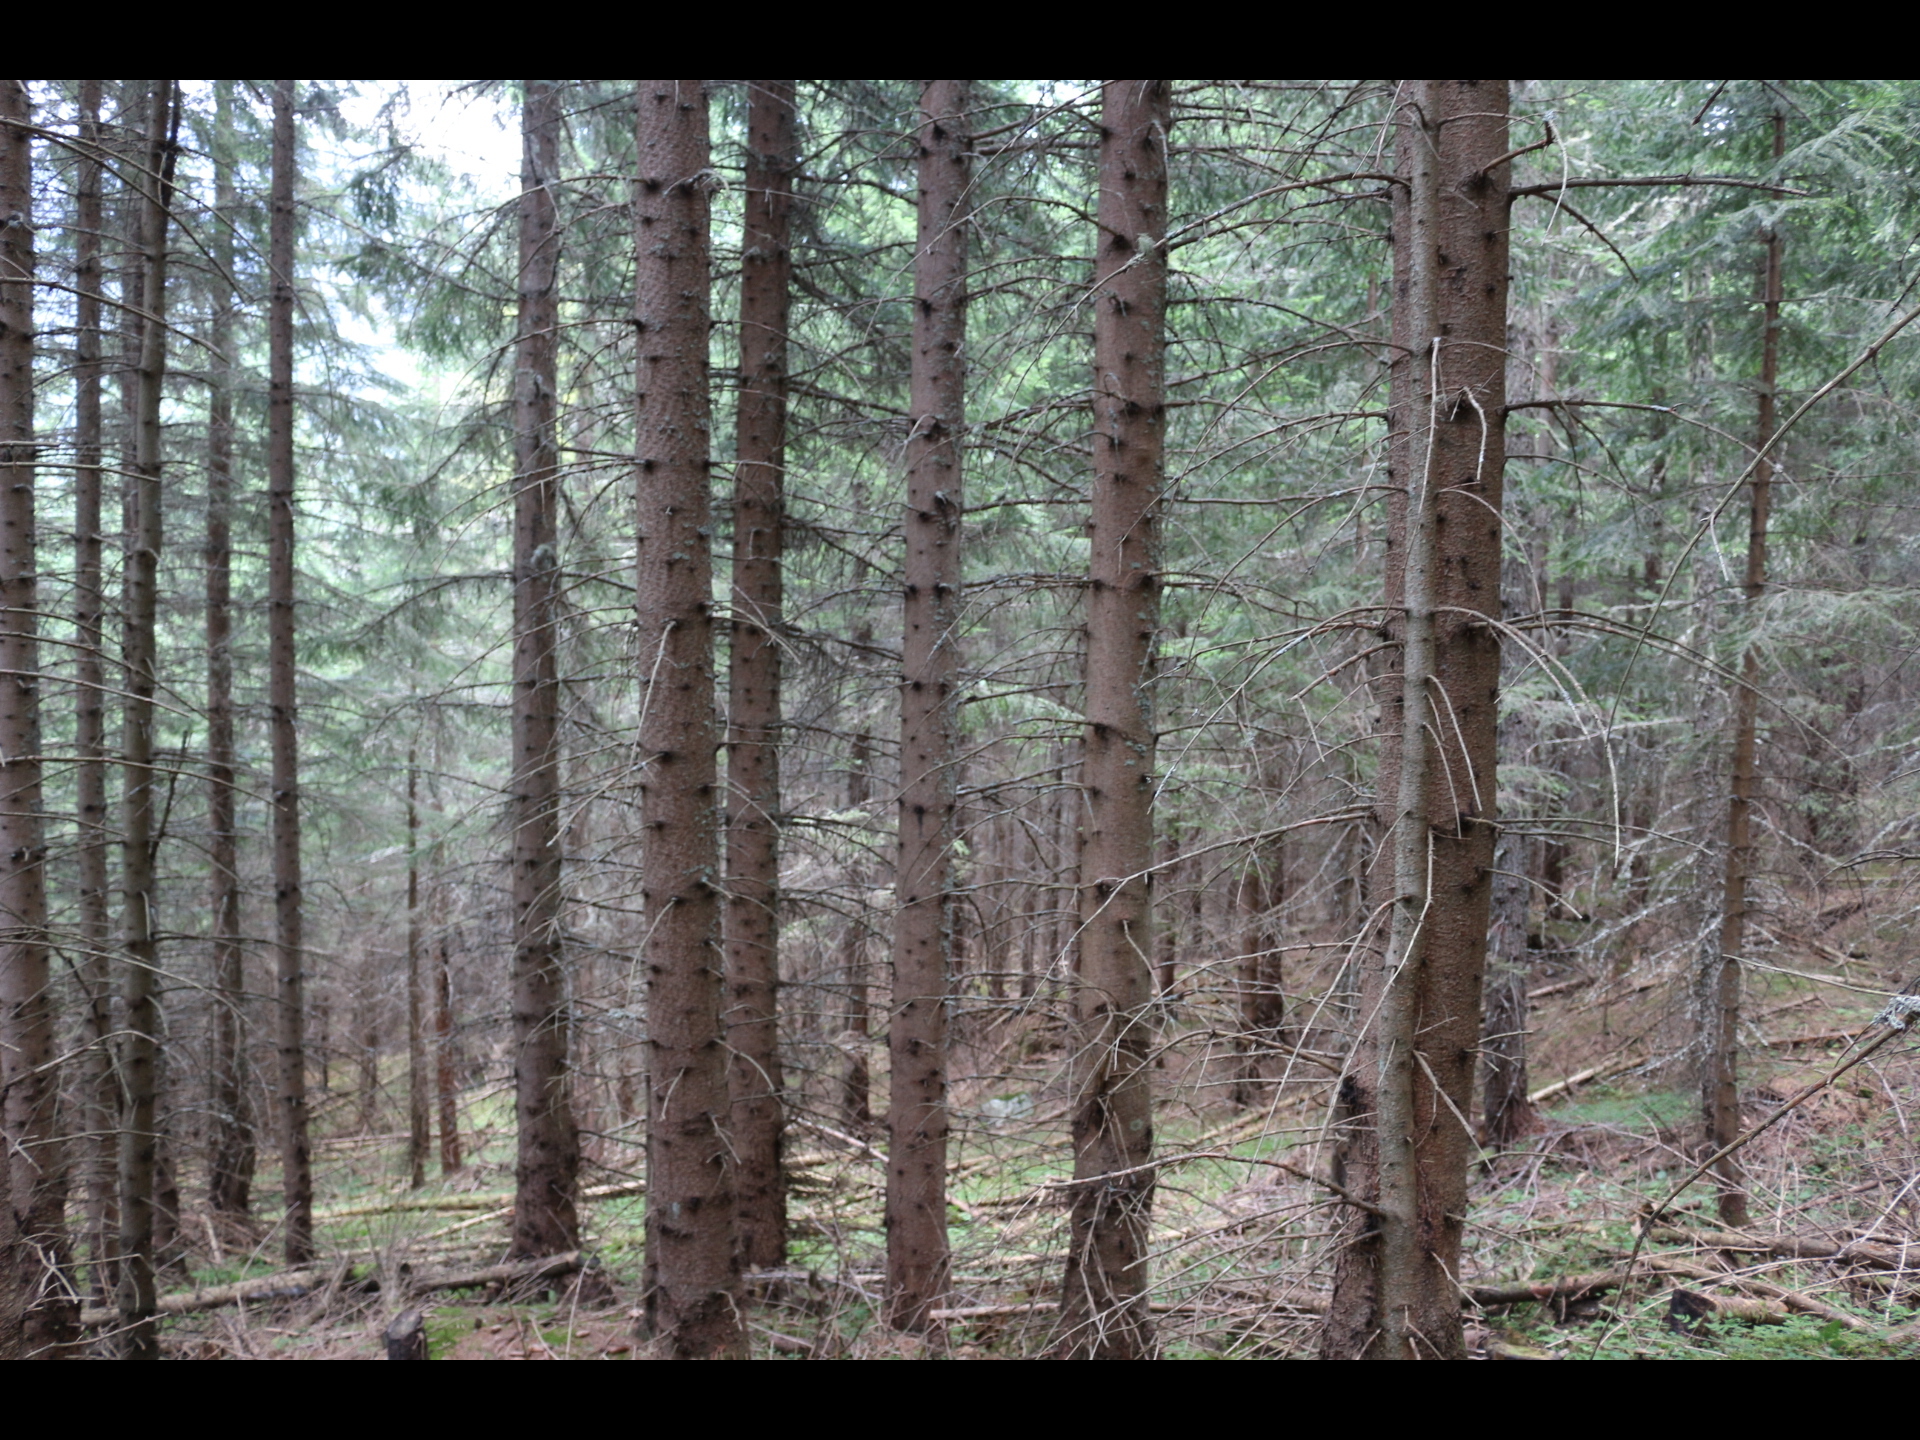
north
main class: Woodland
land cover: Spruce dominated coniferous woodland
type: alpine coniferous forest
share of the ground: > 75 %
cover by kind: coniferous forest trees 85 %, lichens and mosses 10 %, unconsolidated bare surface 5 %
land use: Forestry
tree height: > 5 m
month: August
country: AT
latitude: 46.9414
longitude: 14.0571
